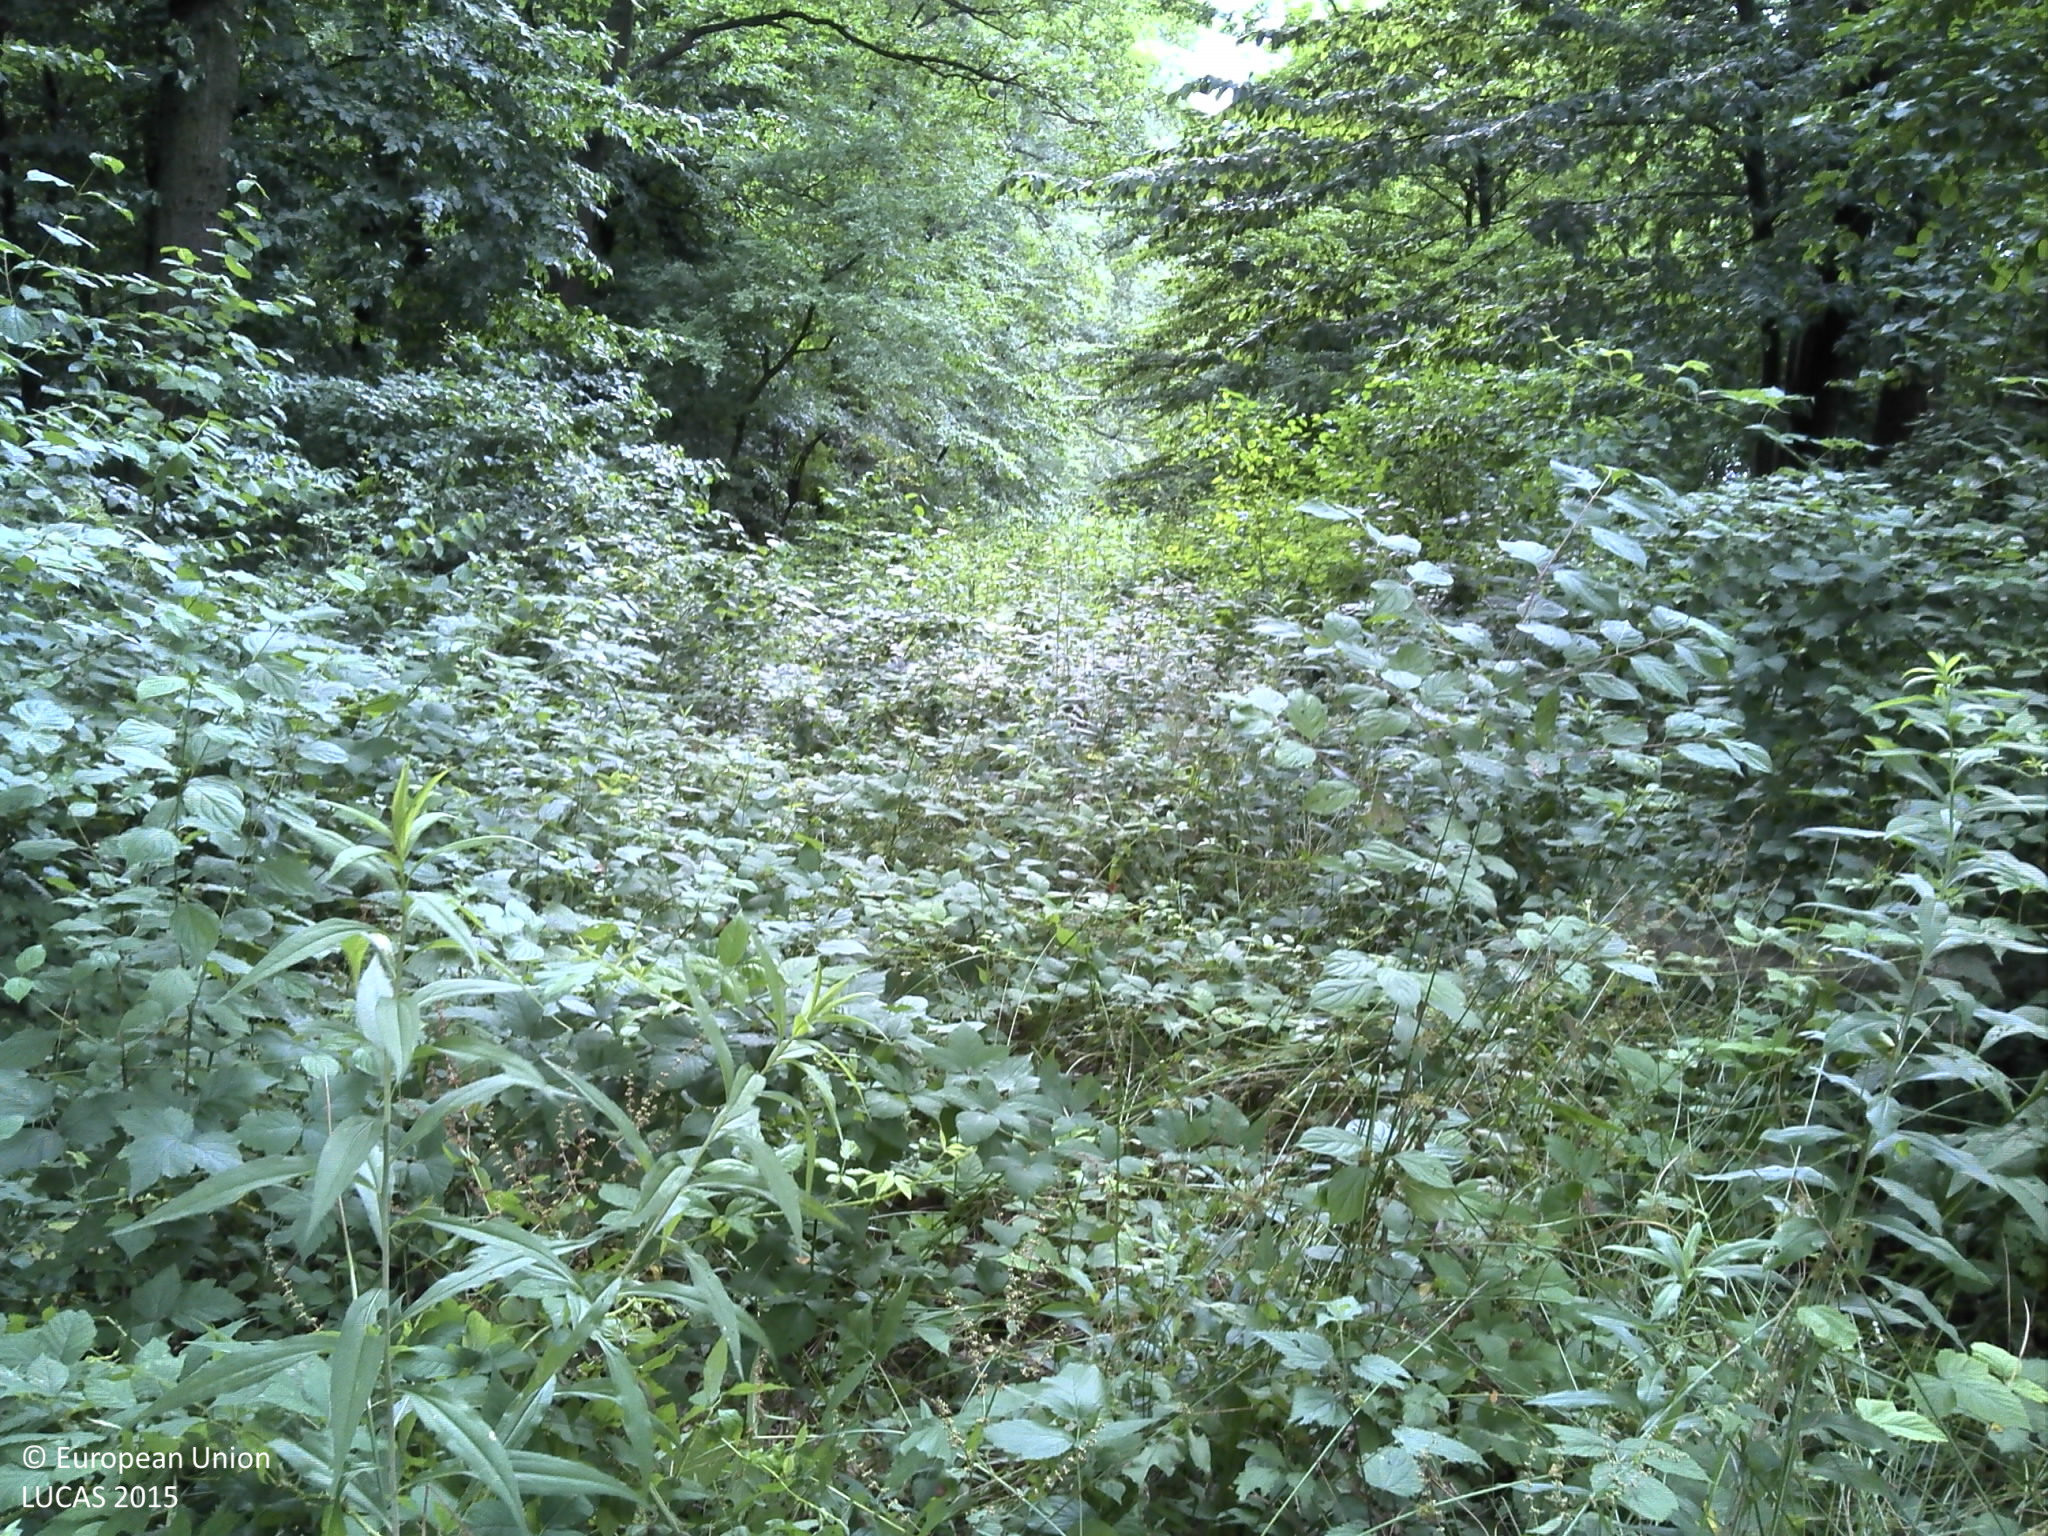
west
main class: Woodland
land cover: Broadleaved woodland
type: acidophilous oak and oak-birch forest
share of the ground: > 75 %
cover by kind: broadleaved forest trees 100 %
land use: Forestry
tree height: > 5 m
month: June
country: HR
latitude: 45.4186
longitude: 18.4528
